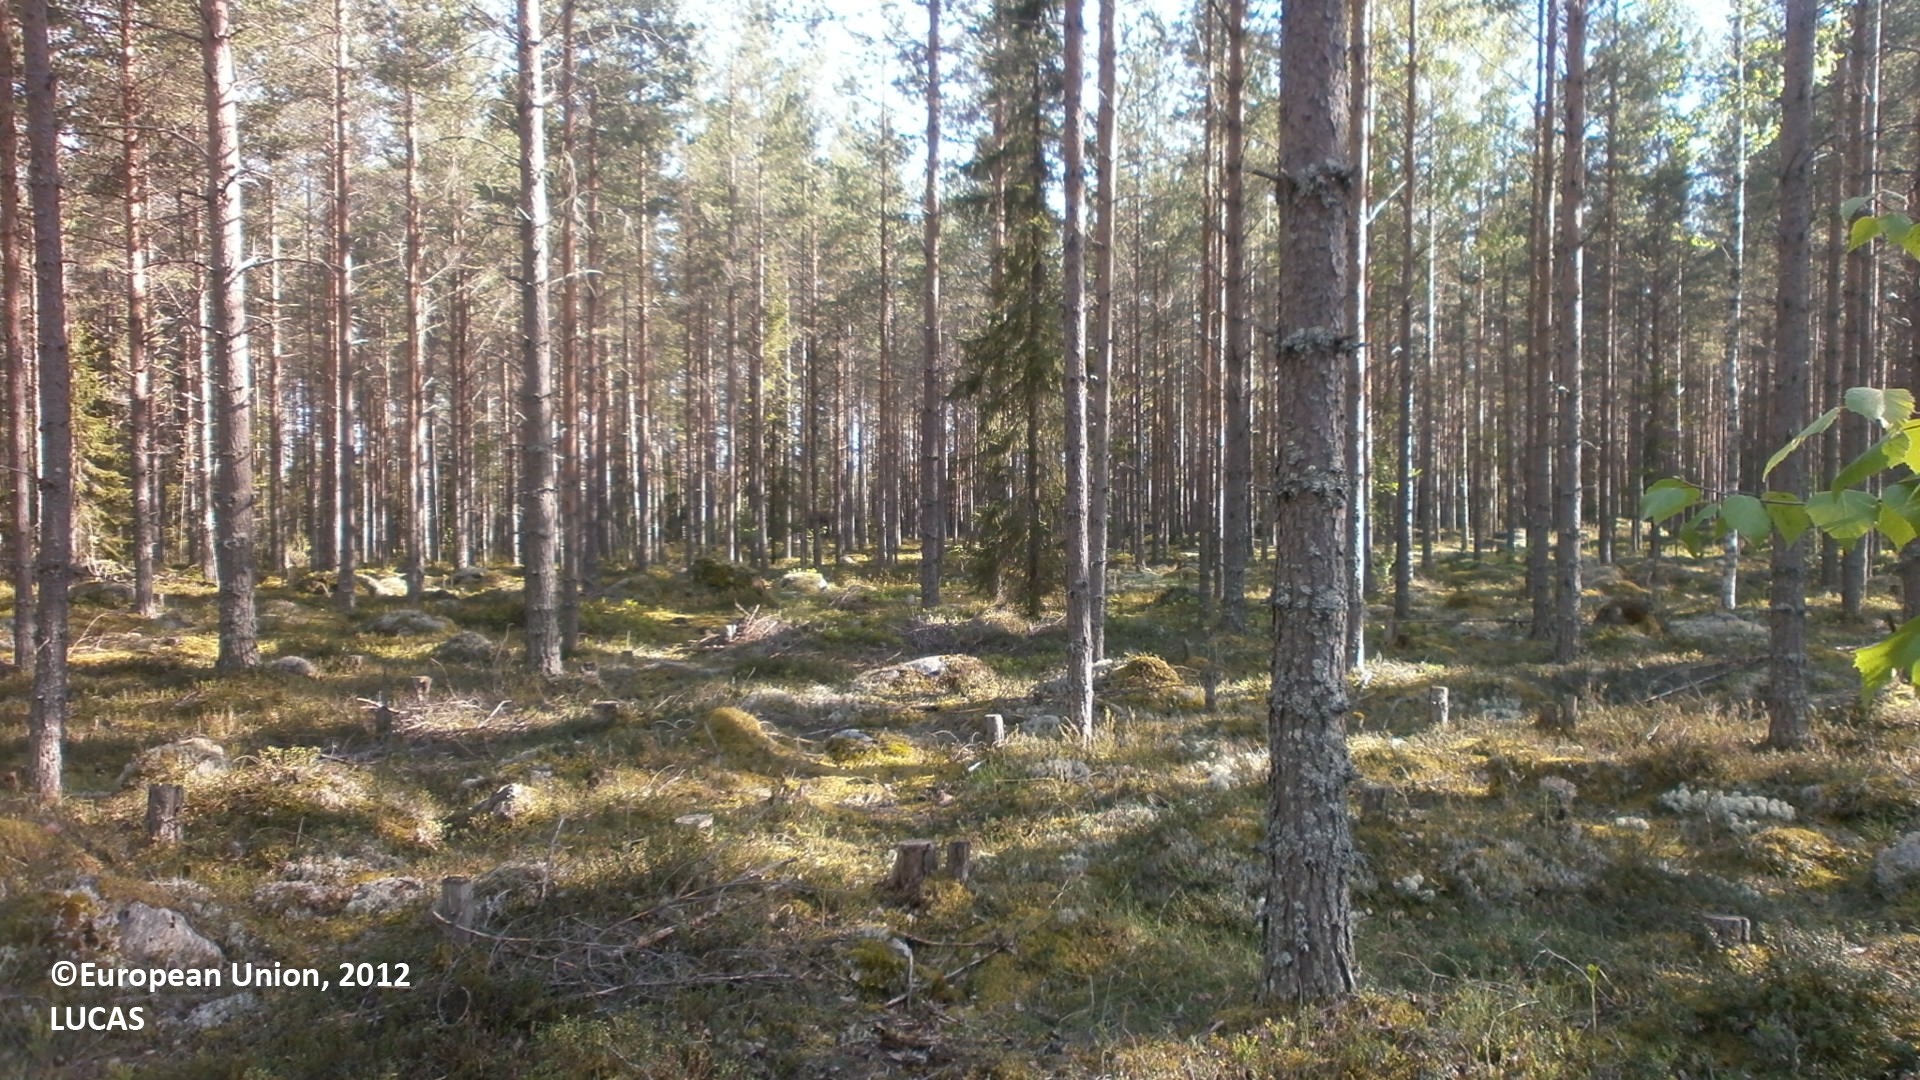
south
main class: Woodland
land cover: Pine dominated coniferous woodland
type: hemiboreal forest and nemoral coniferous forest and mixed broadleaved-coniferous forest
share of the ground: 25 - 50 %
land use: Forestry
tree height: > 5 m
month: June
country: FI
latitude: 64.5540
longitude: 25.1208
